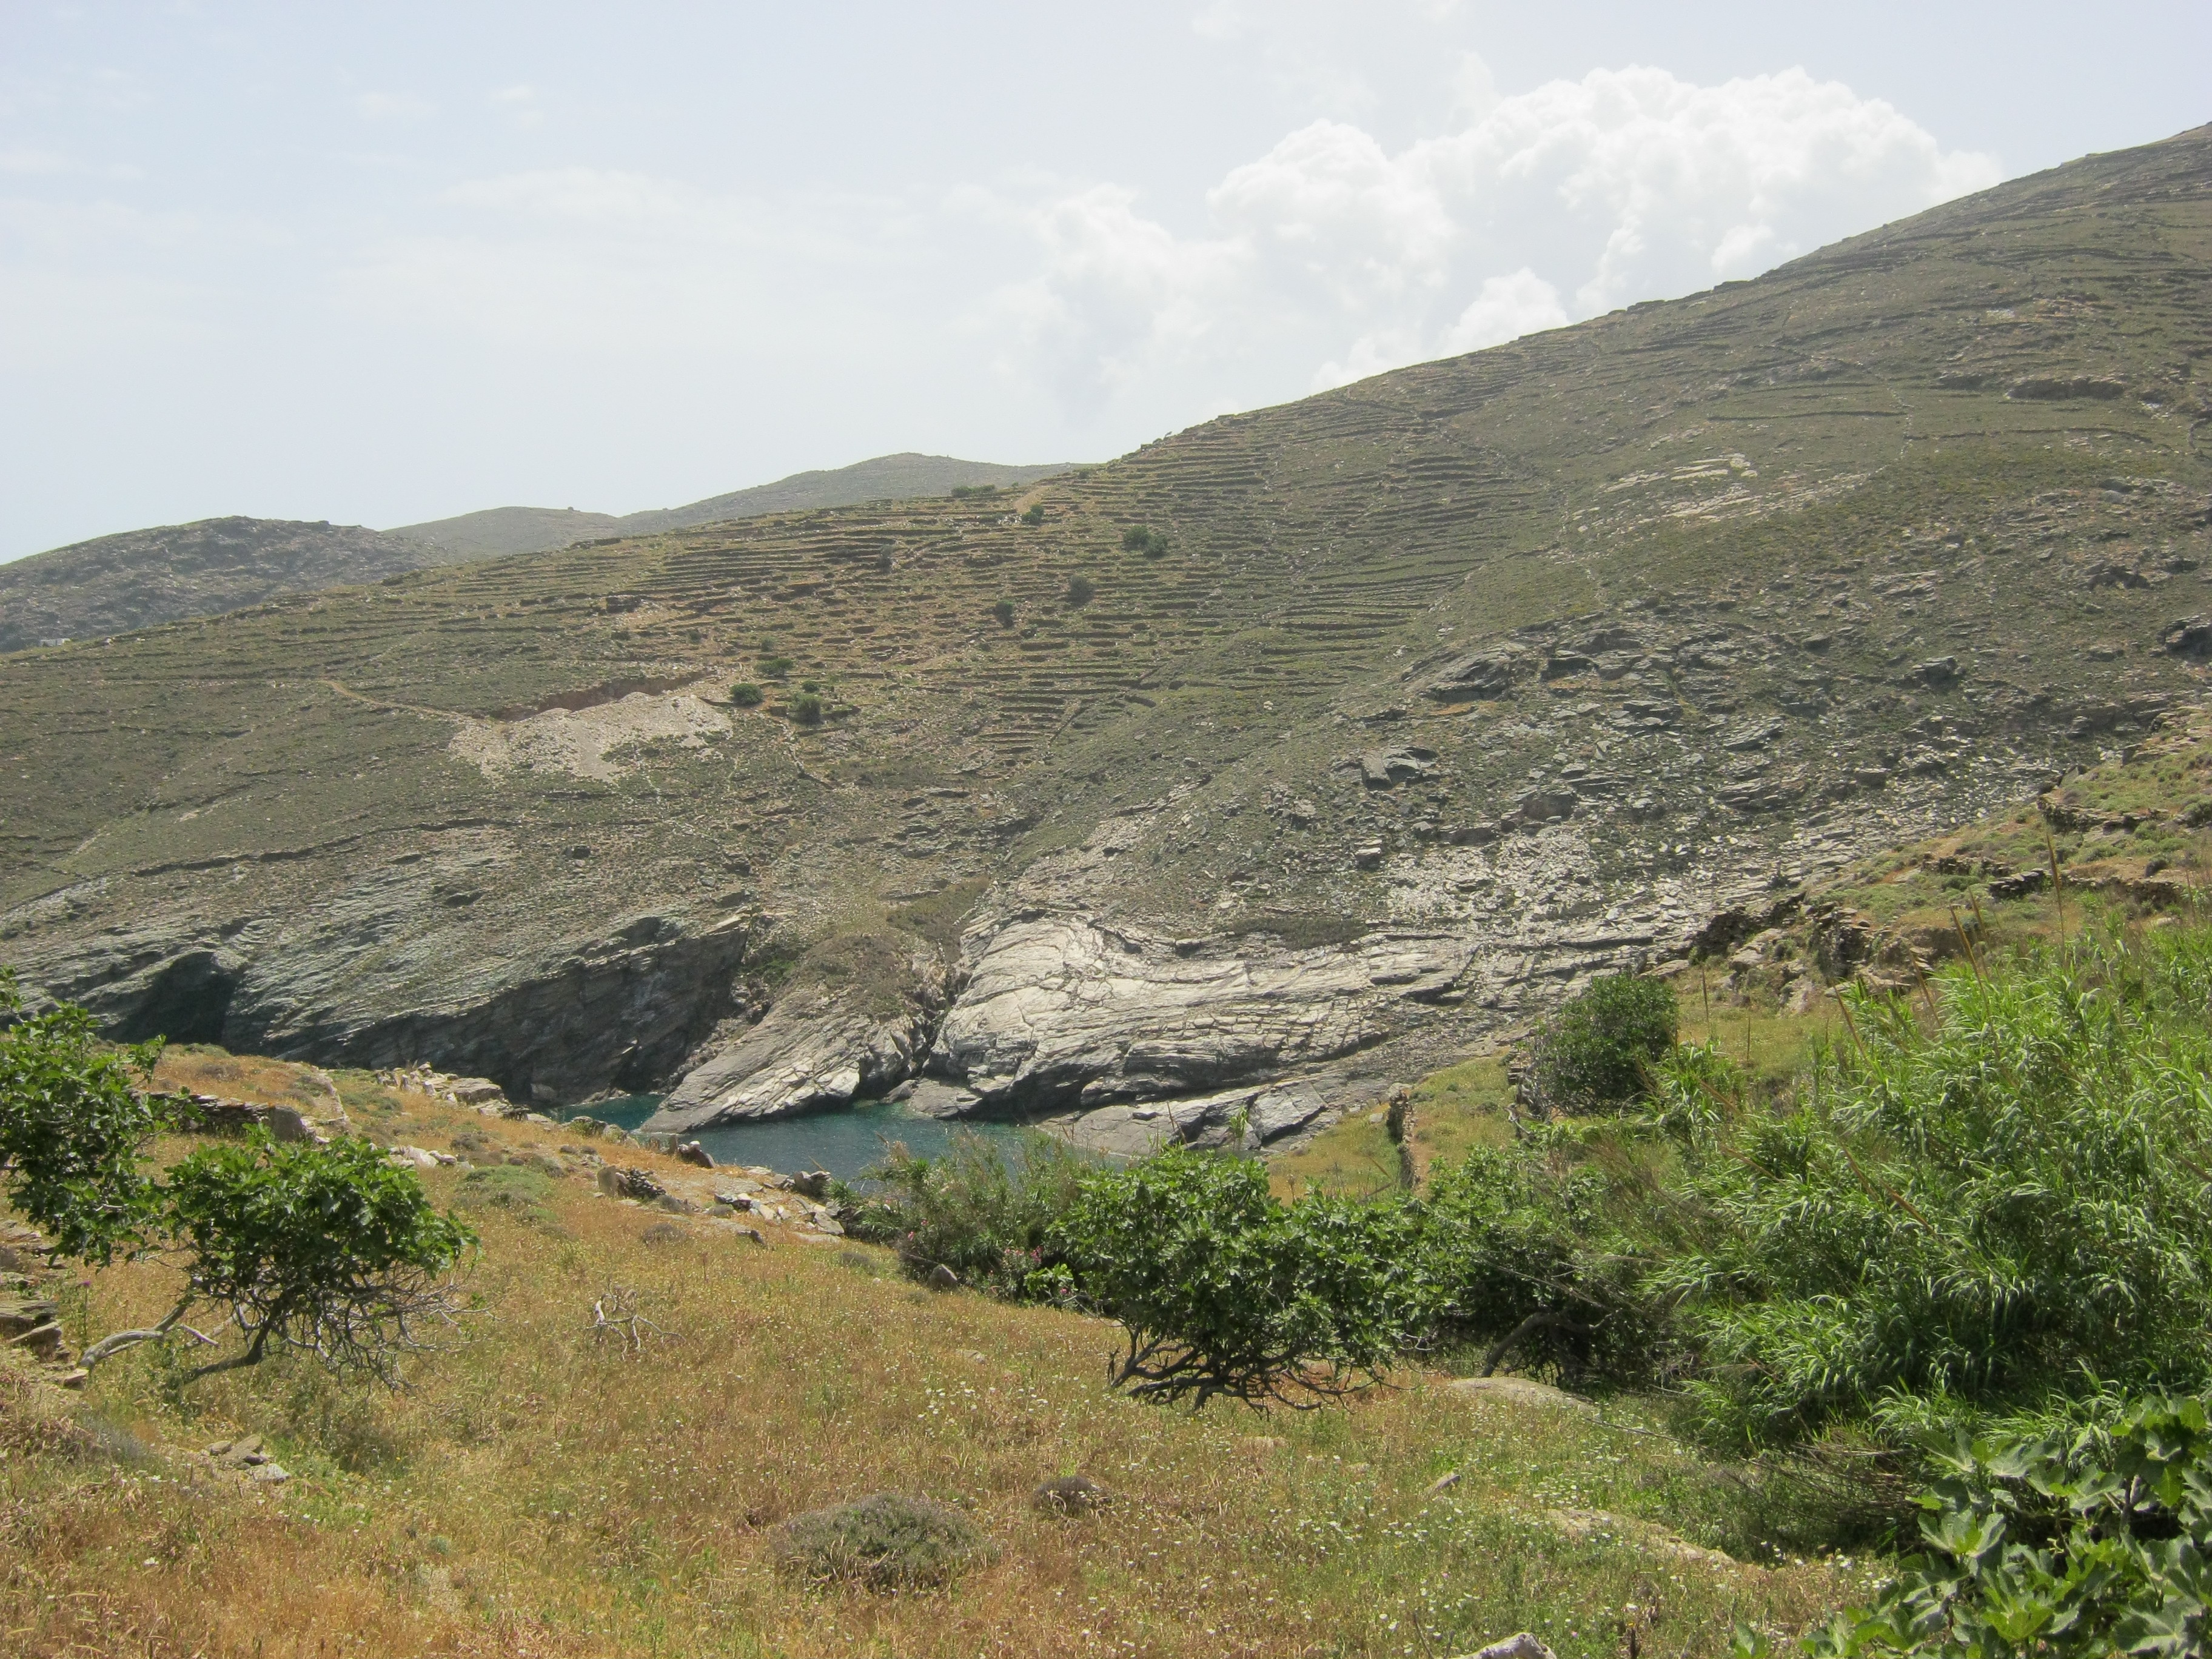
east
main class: Grassland
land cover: Grassland without tree/shrub cover
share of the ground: > 75 %
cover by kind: herbaceous plants 100 %
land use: Semi-natural and natural areas not in use
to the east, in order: Grassland without tree/shrub cover; Dry stone walls; Grassland without tree/shrub cover; Dry stone walls; Grassland without tree/shrub cover; Dry stone walls; Grassland without tree/shrub cover; Dry stone walls; Grassland without tree/shrub cover; Dry stone walls; Grassland without tree/shrub cover; Dry stone walls; Shrubland without tree cover; Rocks and stones
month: May
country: GR
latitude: 37.6424
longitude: 25.0760
